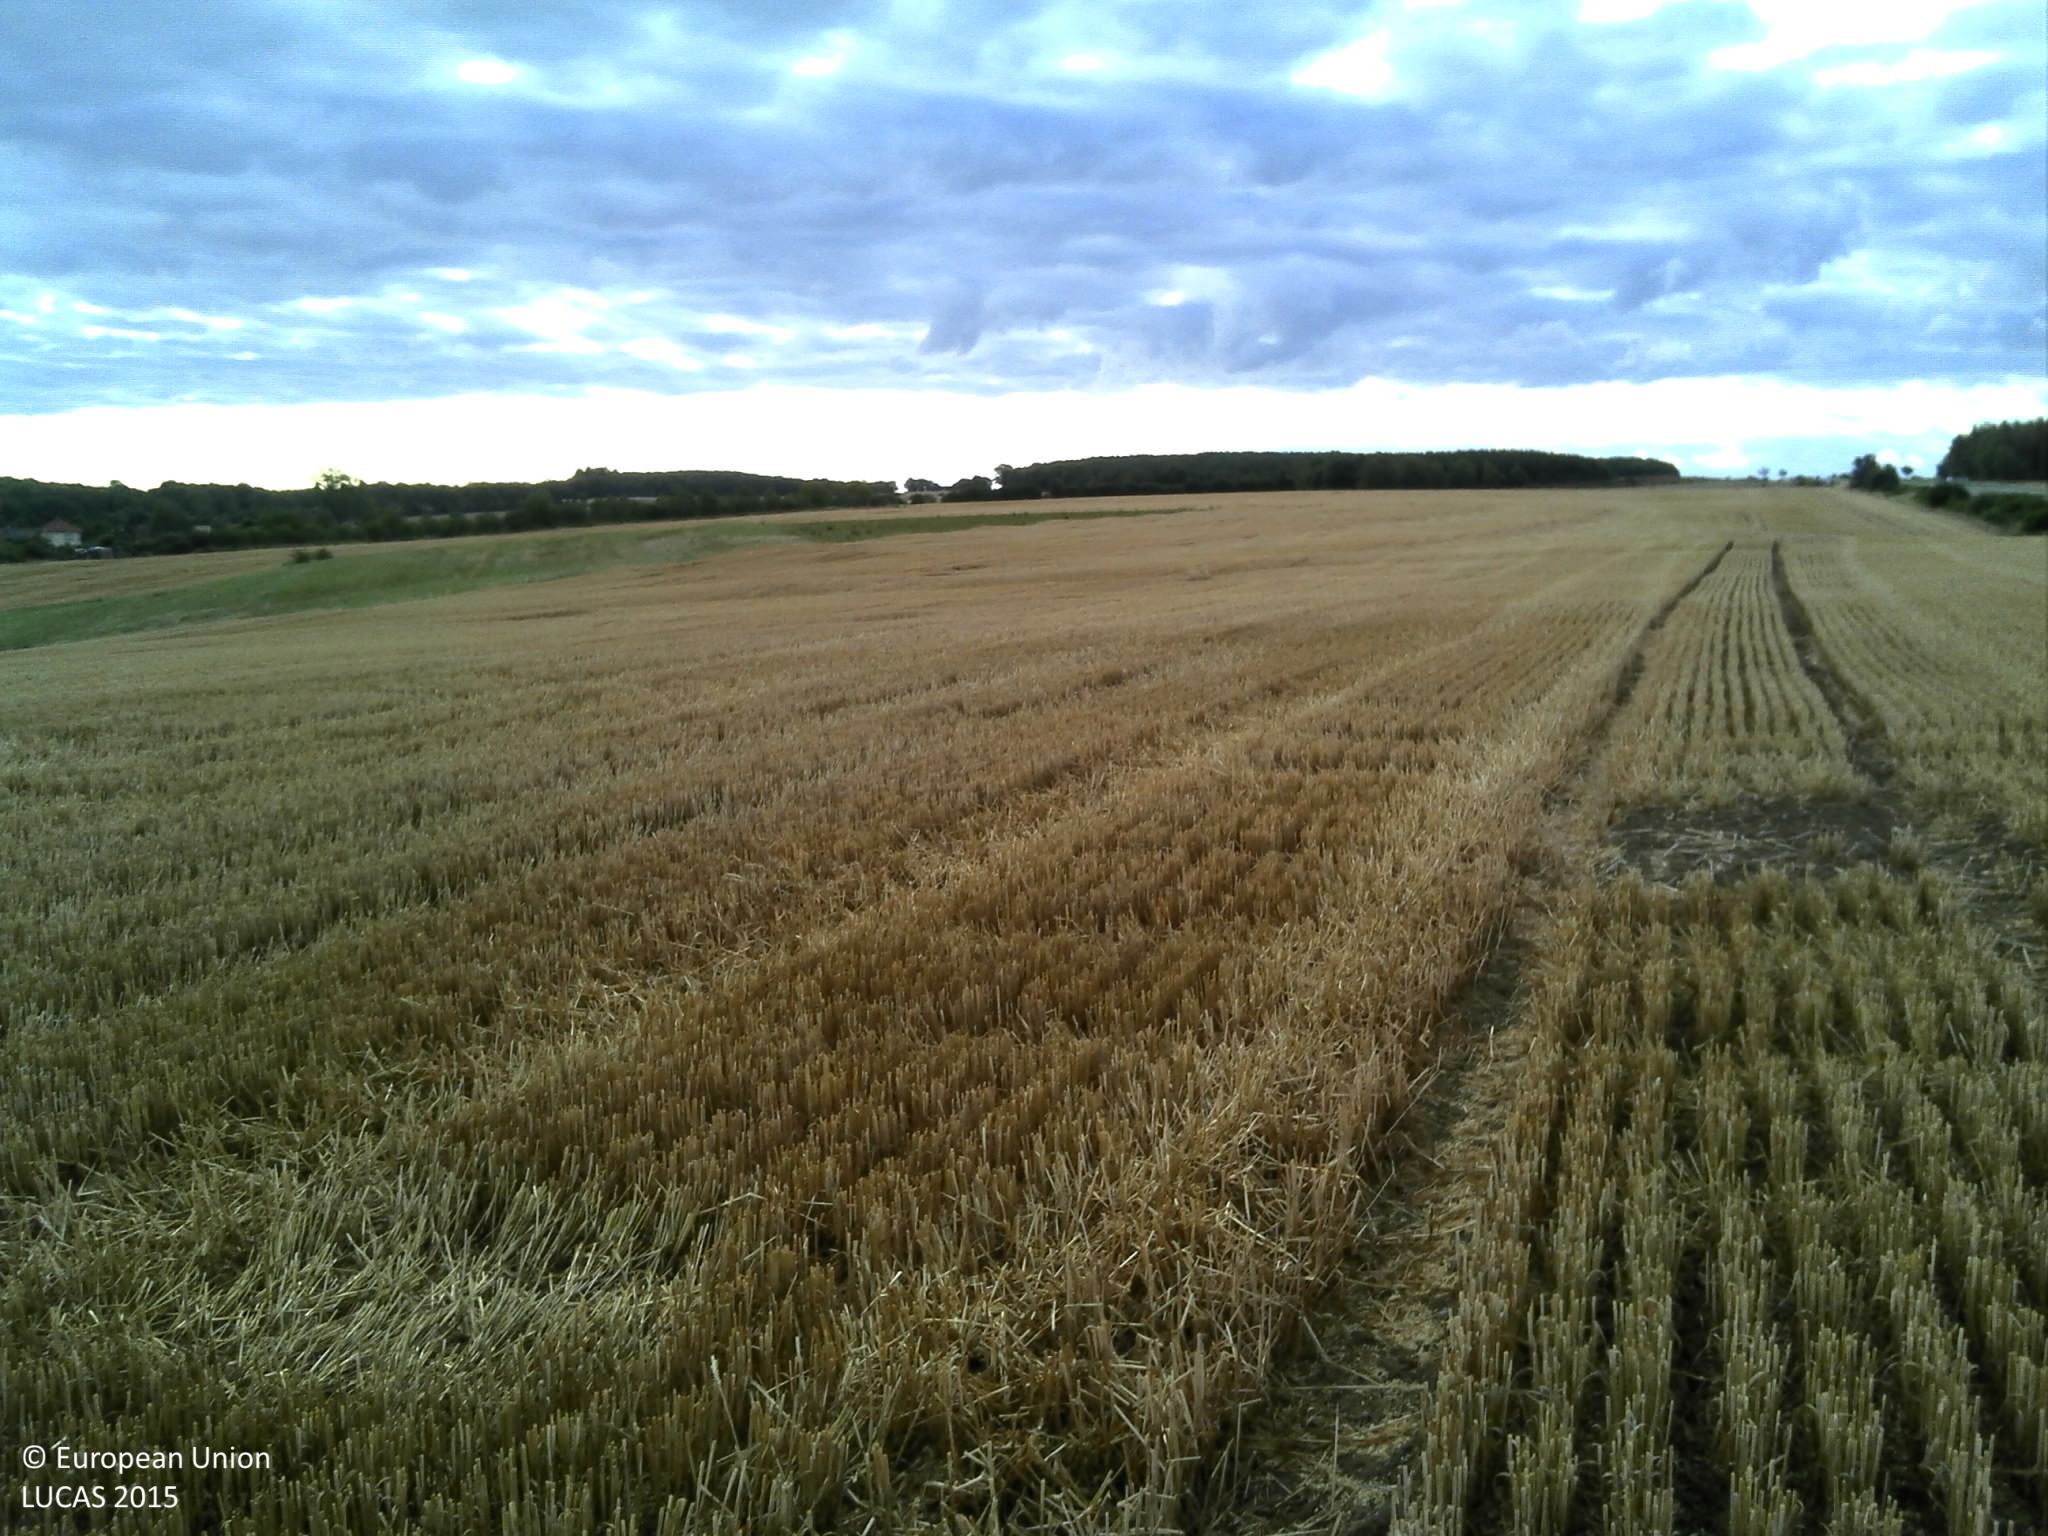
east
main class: Cropland
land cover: Common wheat
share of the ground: < 10 %
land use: Agriculture (excluding fallow land and kitchen gardens)
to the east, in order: Common wheat; Grassland without tree/shrub cover
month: July
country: FR
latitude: 48.2155
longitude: 6.2995
